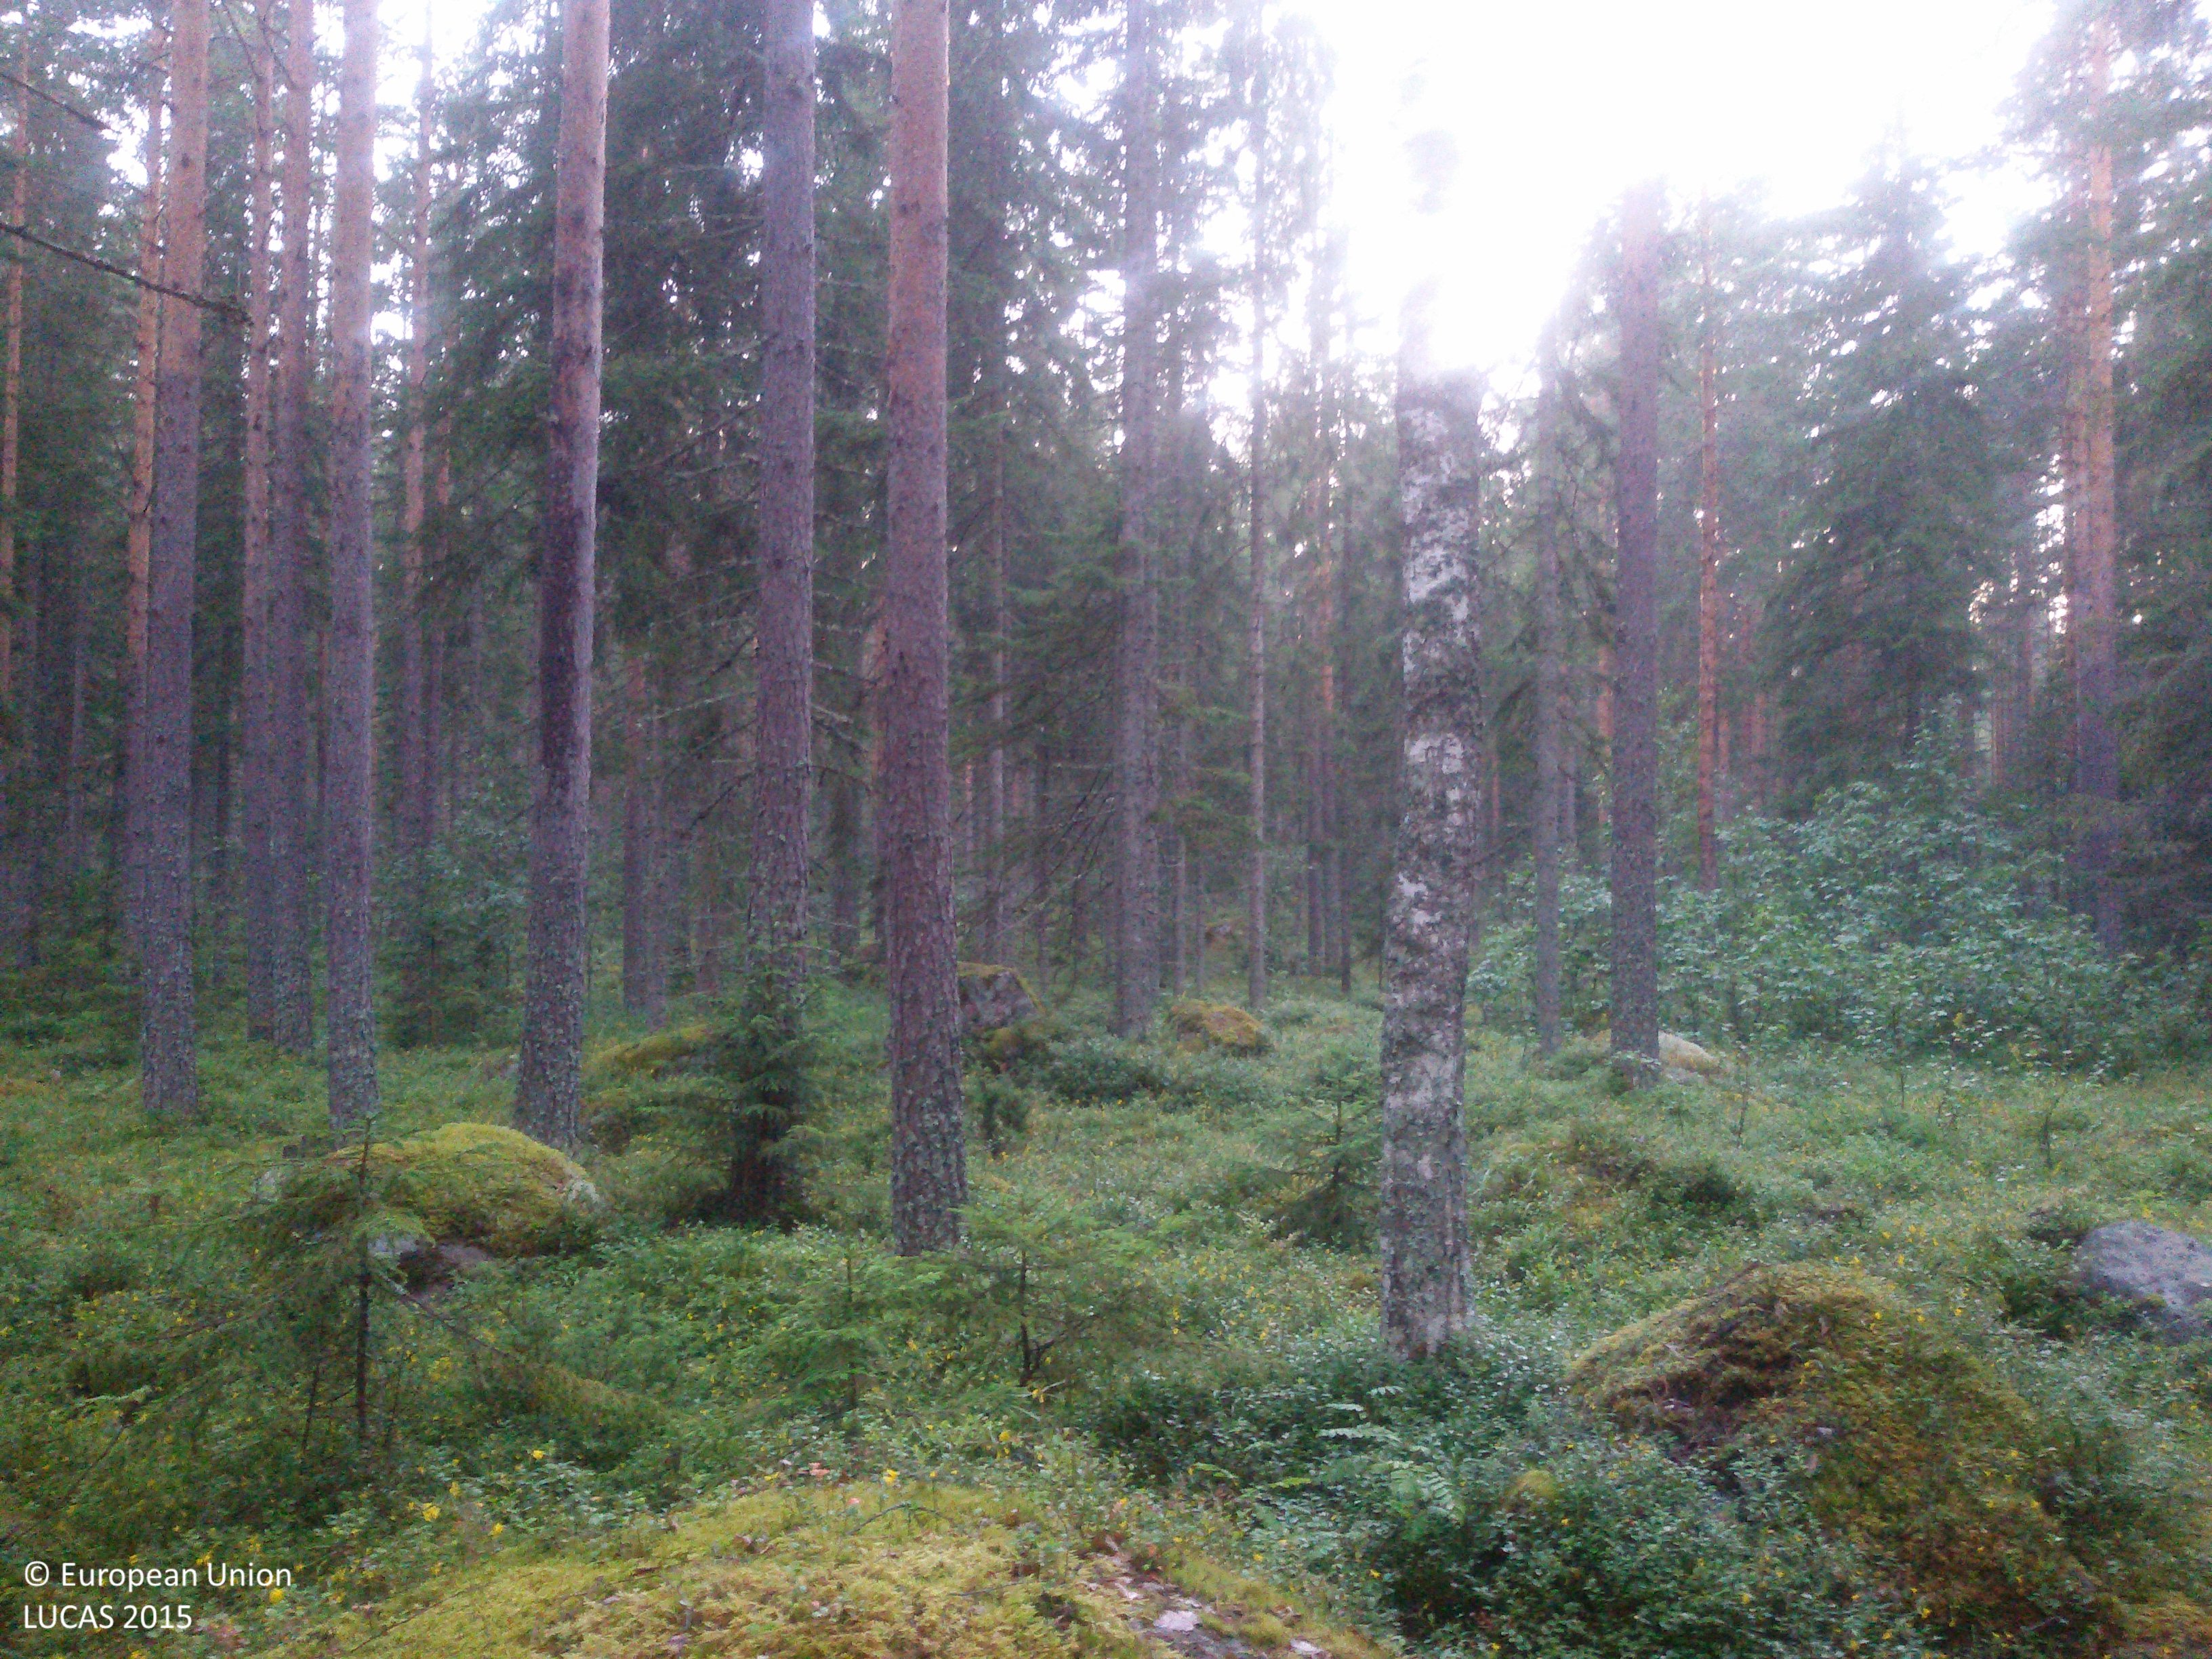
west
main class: Woodland
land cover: Other coniferous woodland
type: boreal forest
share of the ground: 50 - 75 %
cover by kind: coniferous forest trees 55 %, broadleaved forest trees 15 %, shrubs 15 %, lichens and mosses 10 %, herbaceous plants 5 %
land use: Forestry
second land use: Sport
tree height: > 5 m
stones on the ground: > 50 %
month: August
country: SE
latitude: 60.7991
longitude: 16.6944
